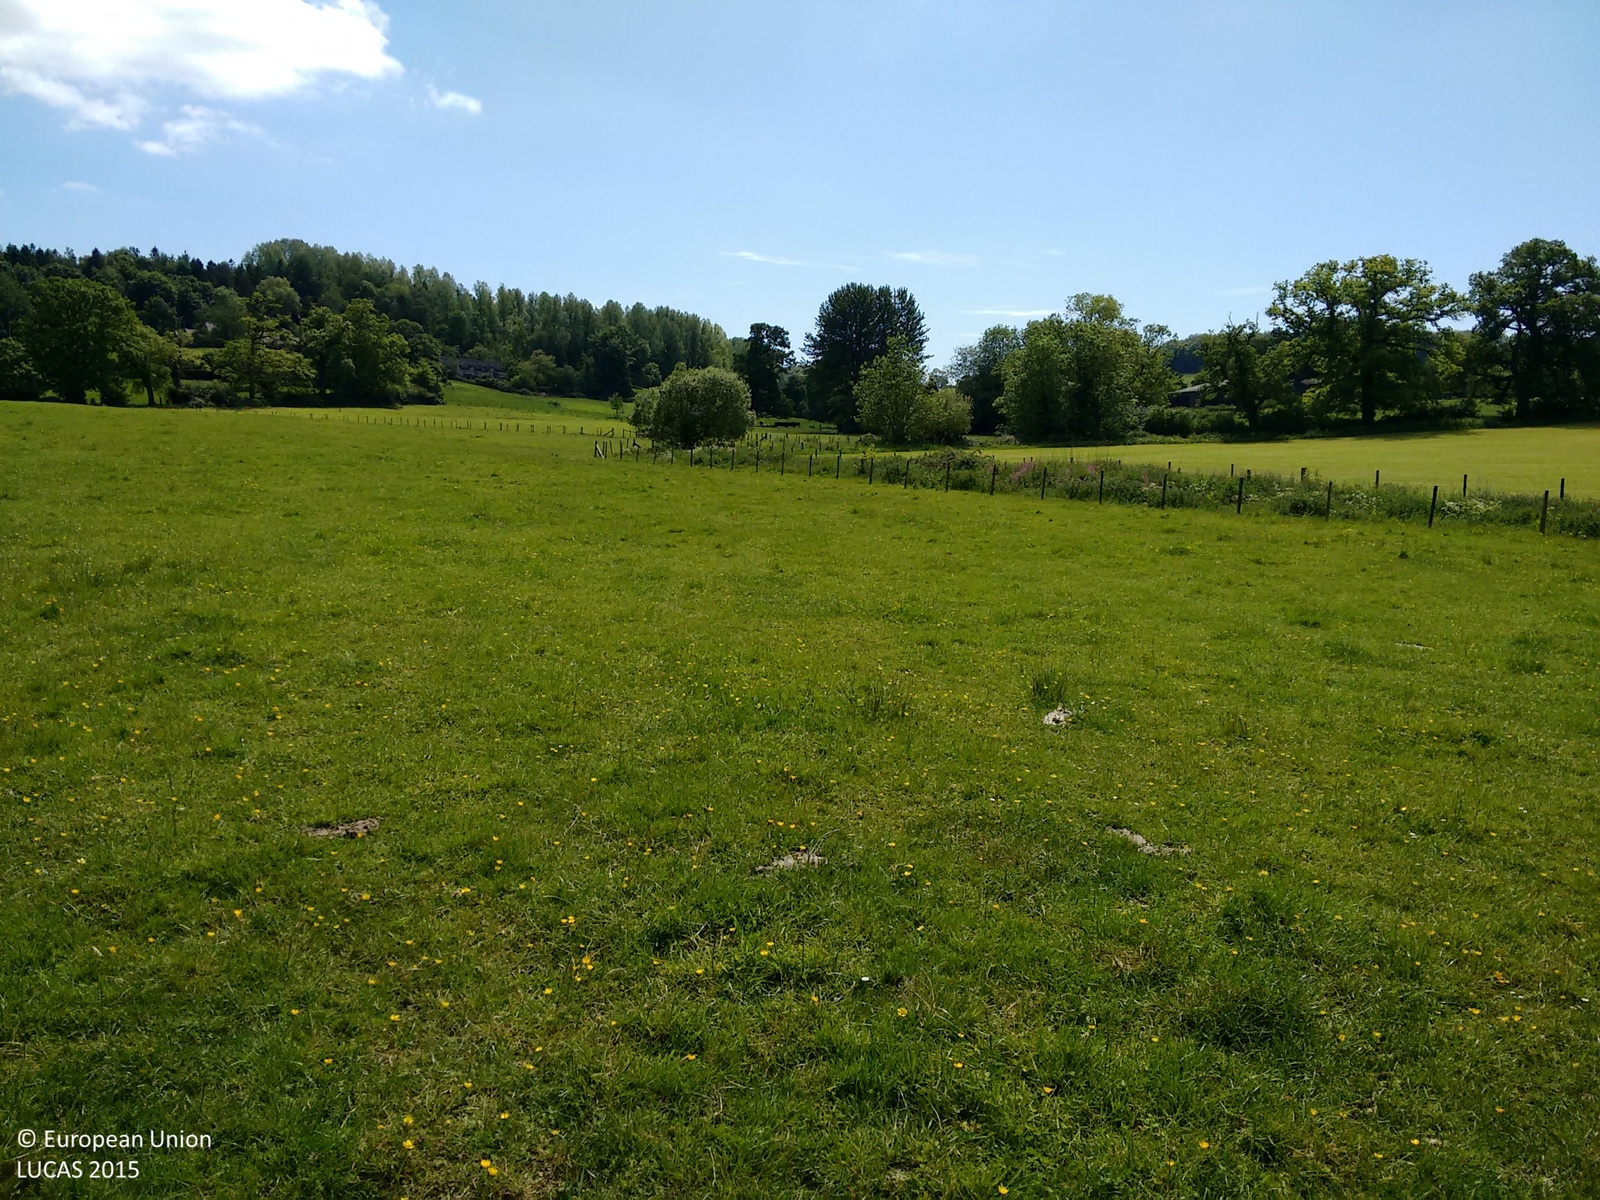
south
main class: Grassland
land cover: Grassland without tree/shrub cover
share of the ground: > 75 %
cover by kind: herbaceous plants 100 %
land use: Agriculture (excluding fallow land and kitchen gardens)
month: June
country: GB
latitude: 51.1747
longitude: -2.2635
